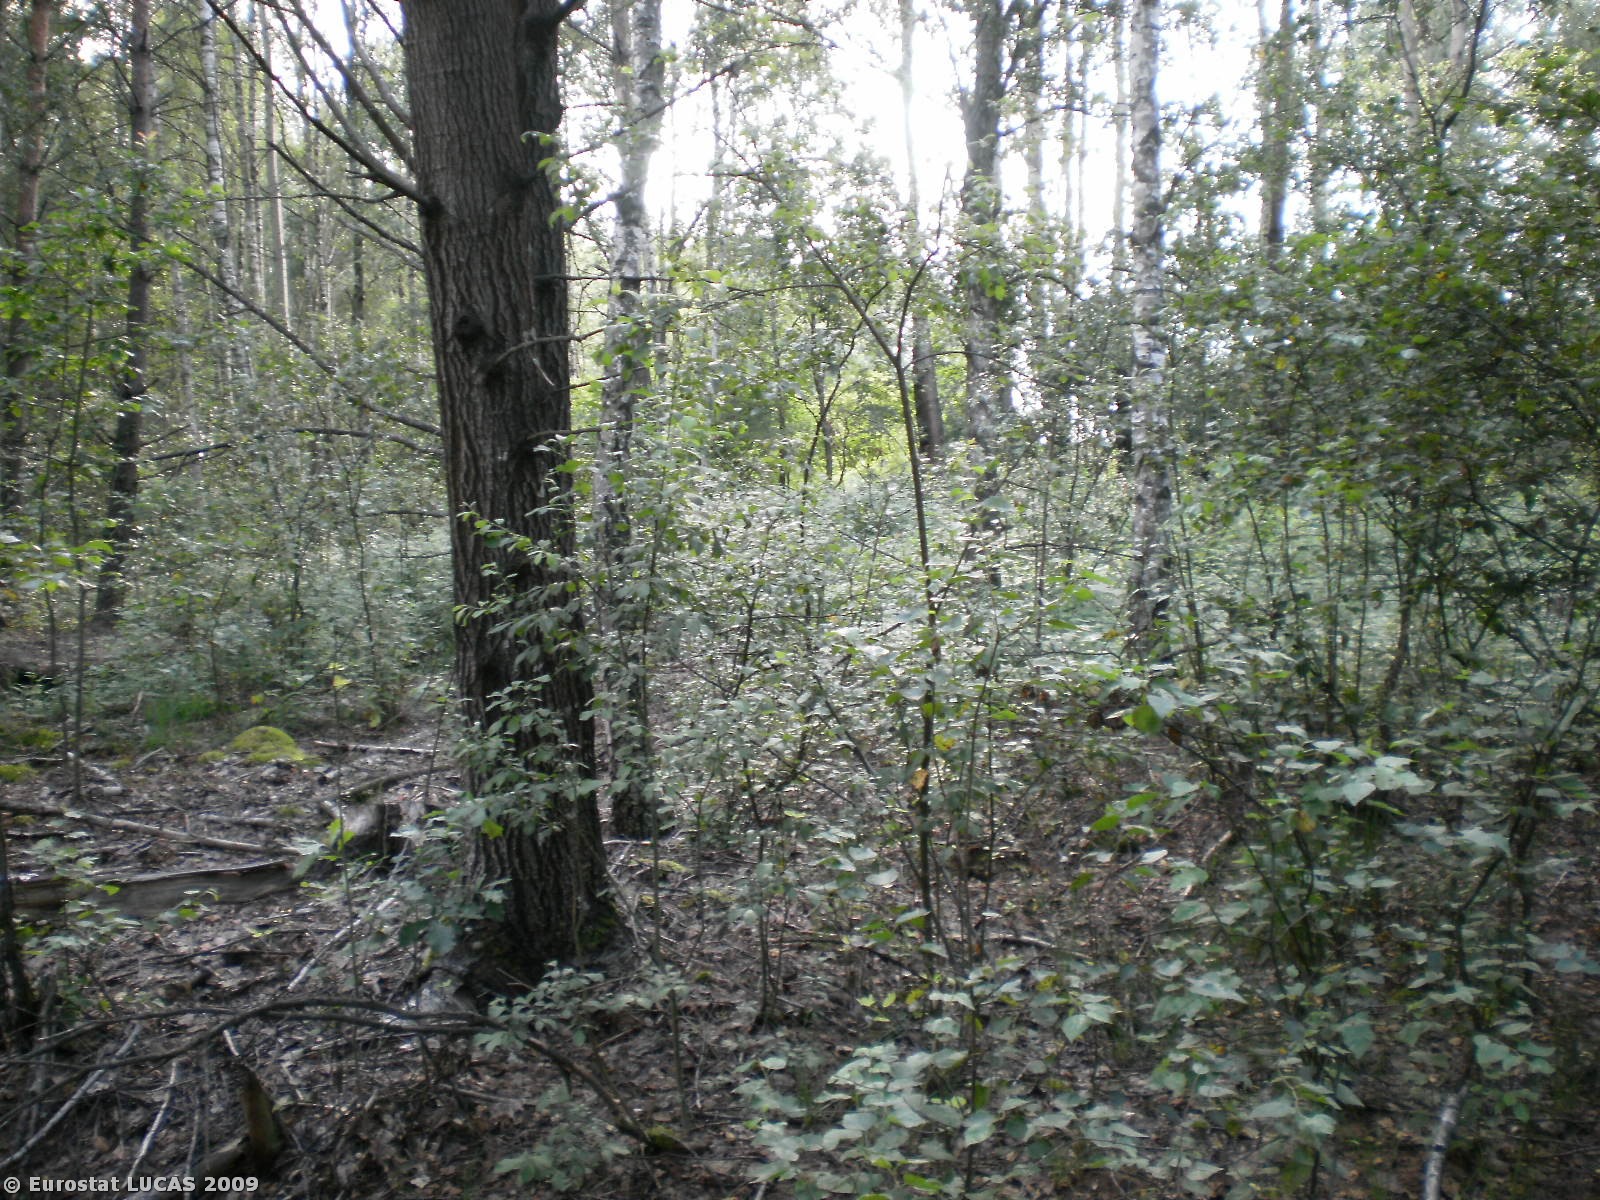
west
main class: Woodland
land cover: Mixed woodland
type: hemiboreal forest and nemoral coniferous forest and mixed broadleaved-coniferous forest
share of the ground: > 75 %
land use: Nature reserves
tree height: > 5 m
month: July
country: PL
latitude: 53.6089
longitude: 20.5726
